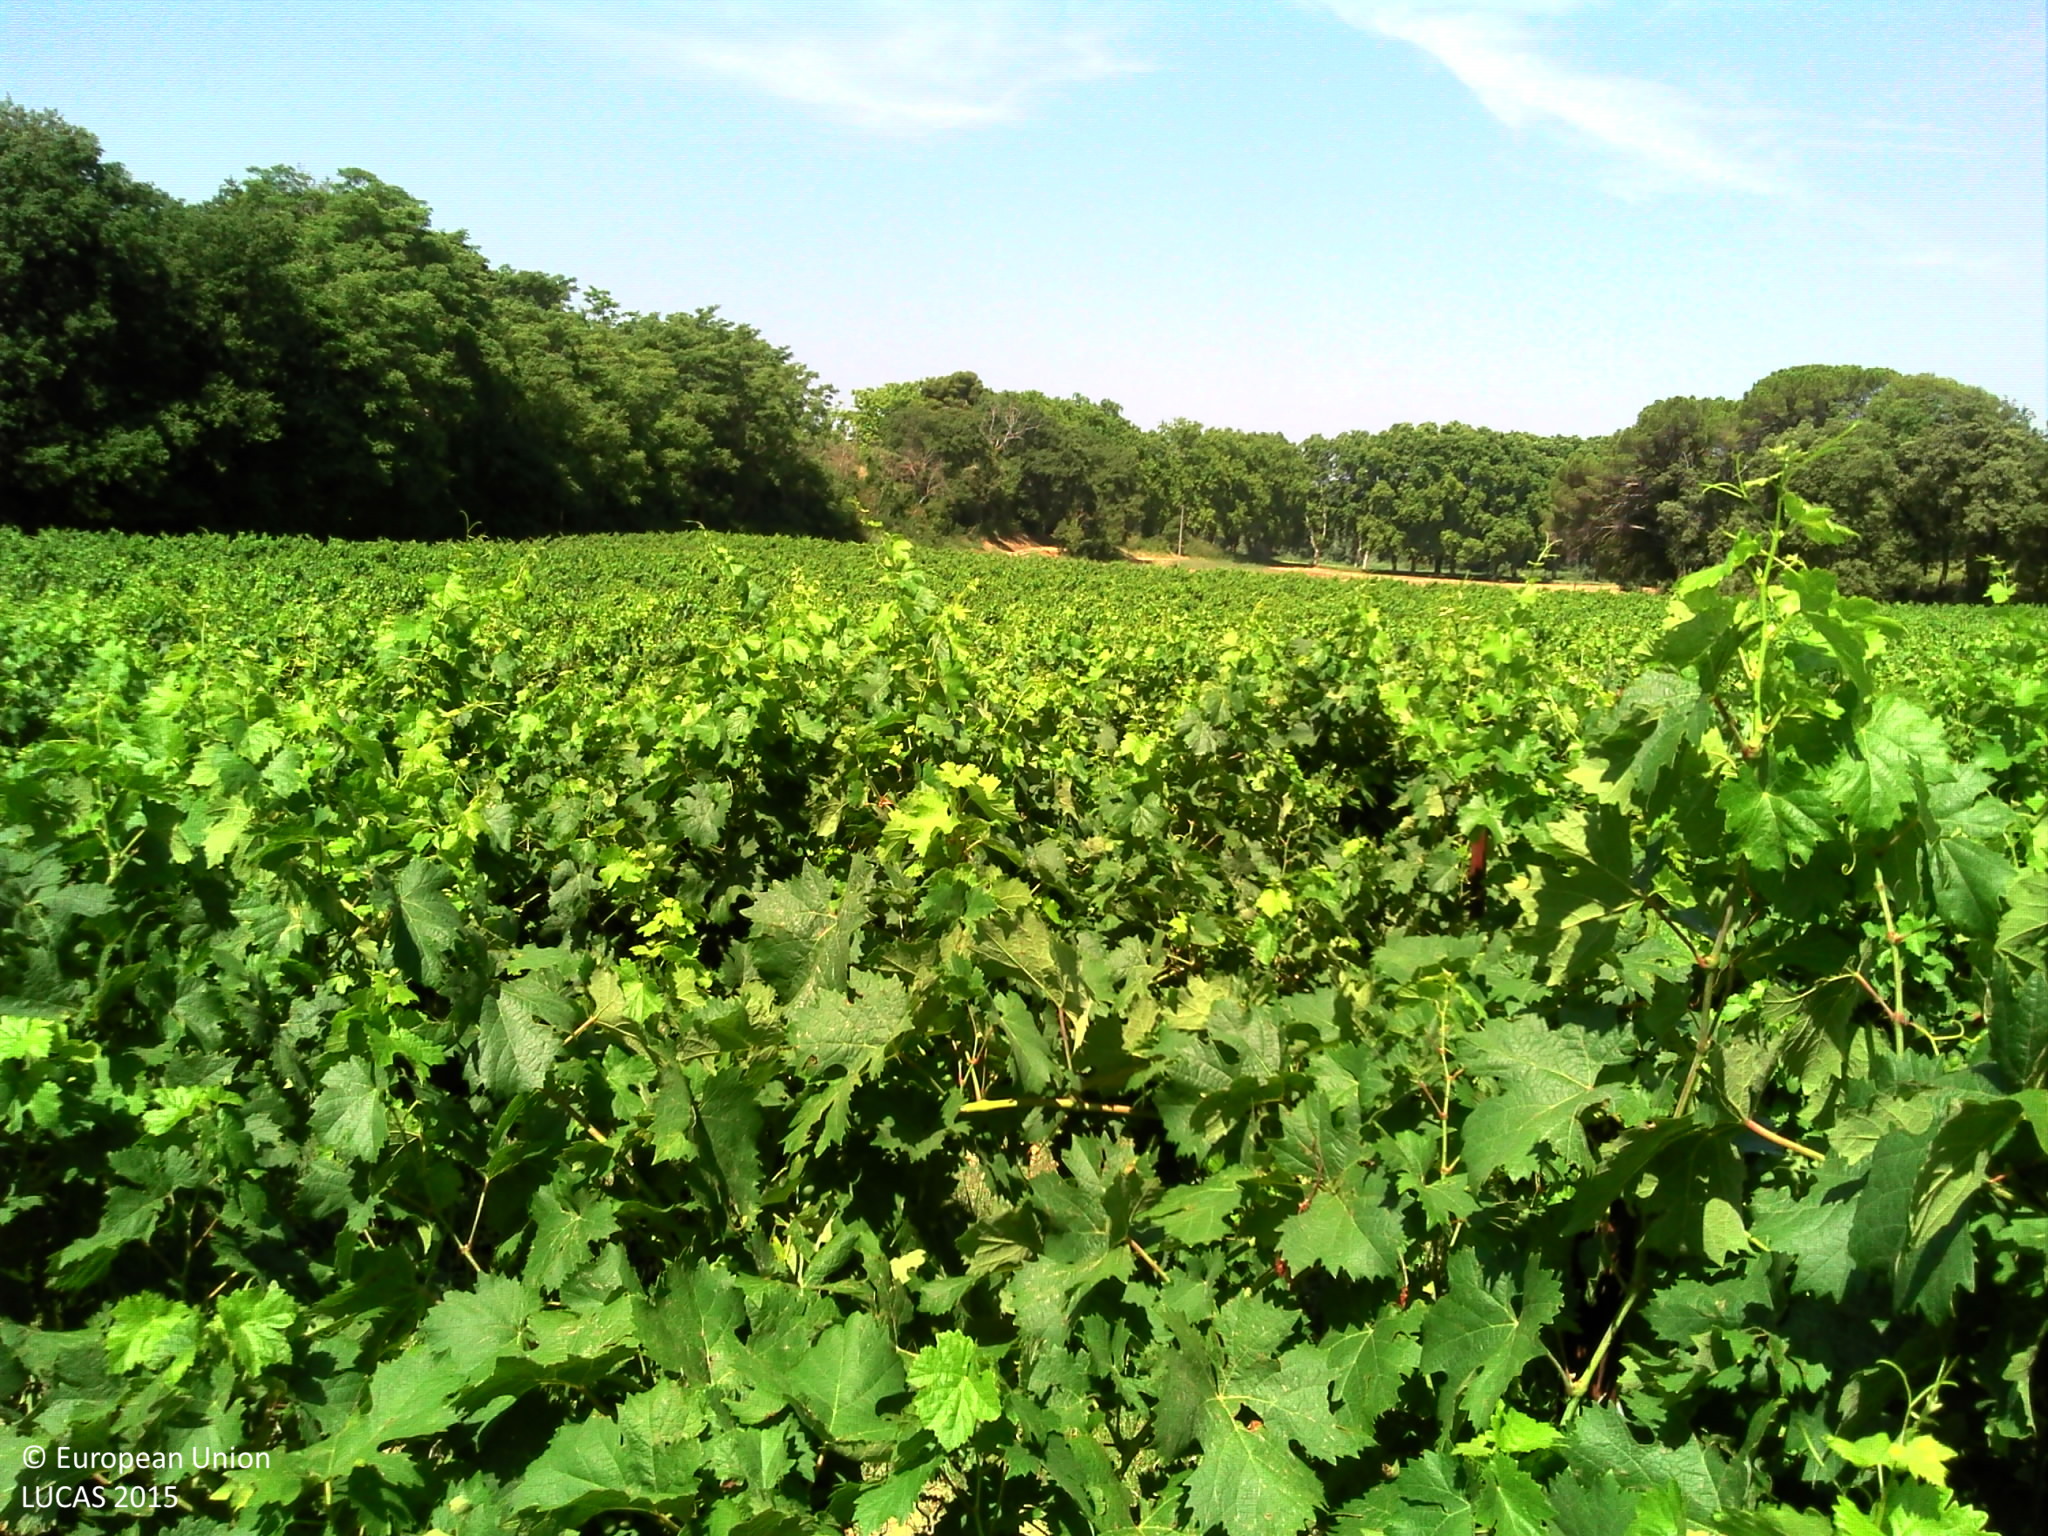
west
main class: Cropland
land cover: Vineyards
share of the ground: 25 - 50 %
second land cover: Grassland without tree/shrub cover
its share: 50 - 75 %
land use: Agriculture (excluding fallow land and kitchen gardens)
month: July
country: FR
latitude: 43.7144
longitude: 5.5781
